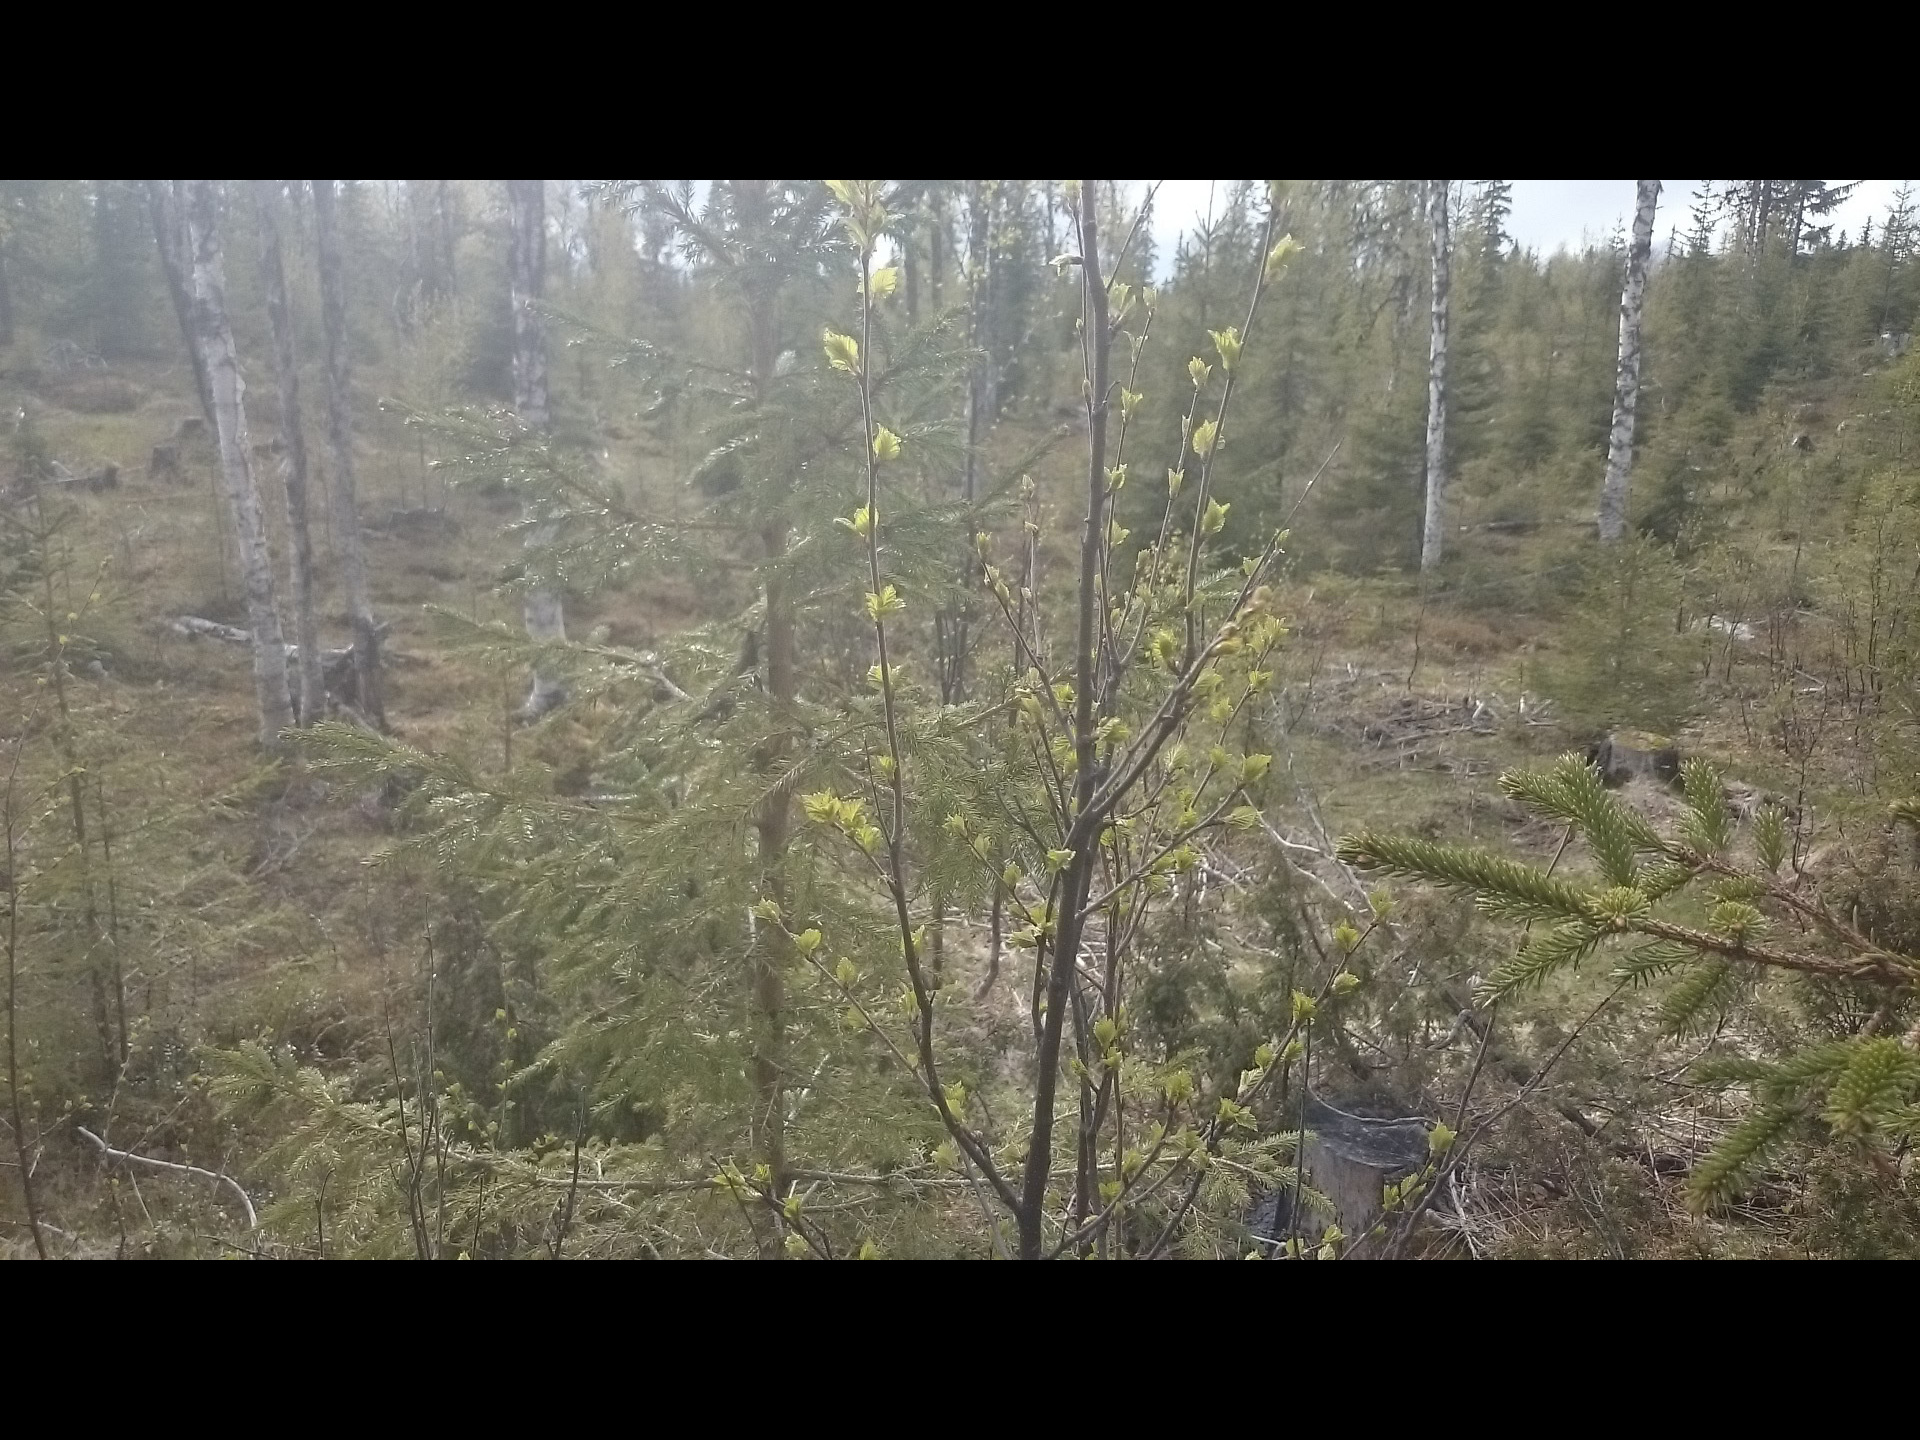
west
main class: Woodland
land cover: Spruce dominated mixed woodland
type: boreal forest
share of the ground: 25 - 50 %
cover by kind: herbaceous plants 35 %, coniferous forest trees 30 %, shrubs 25 %, broadleaved forest trees 10 %
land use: Forestry
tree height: < 5 m
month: June
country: SE
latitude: 63.7189
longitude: 13.8459
